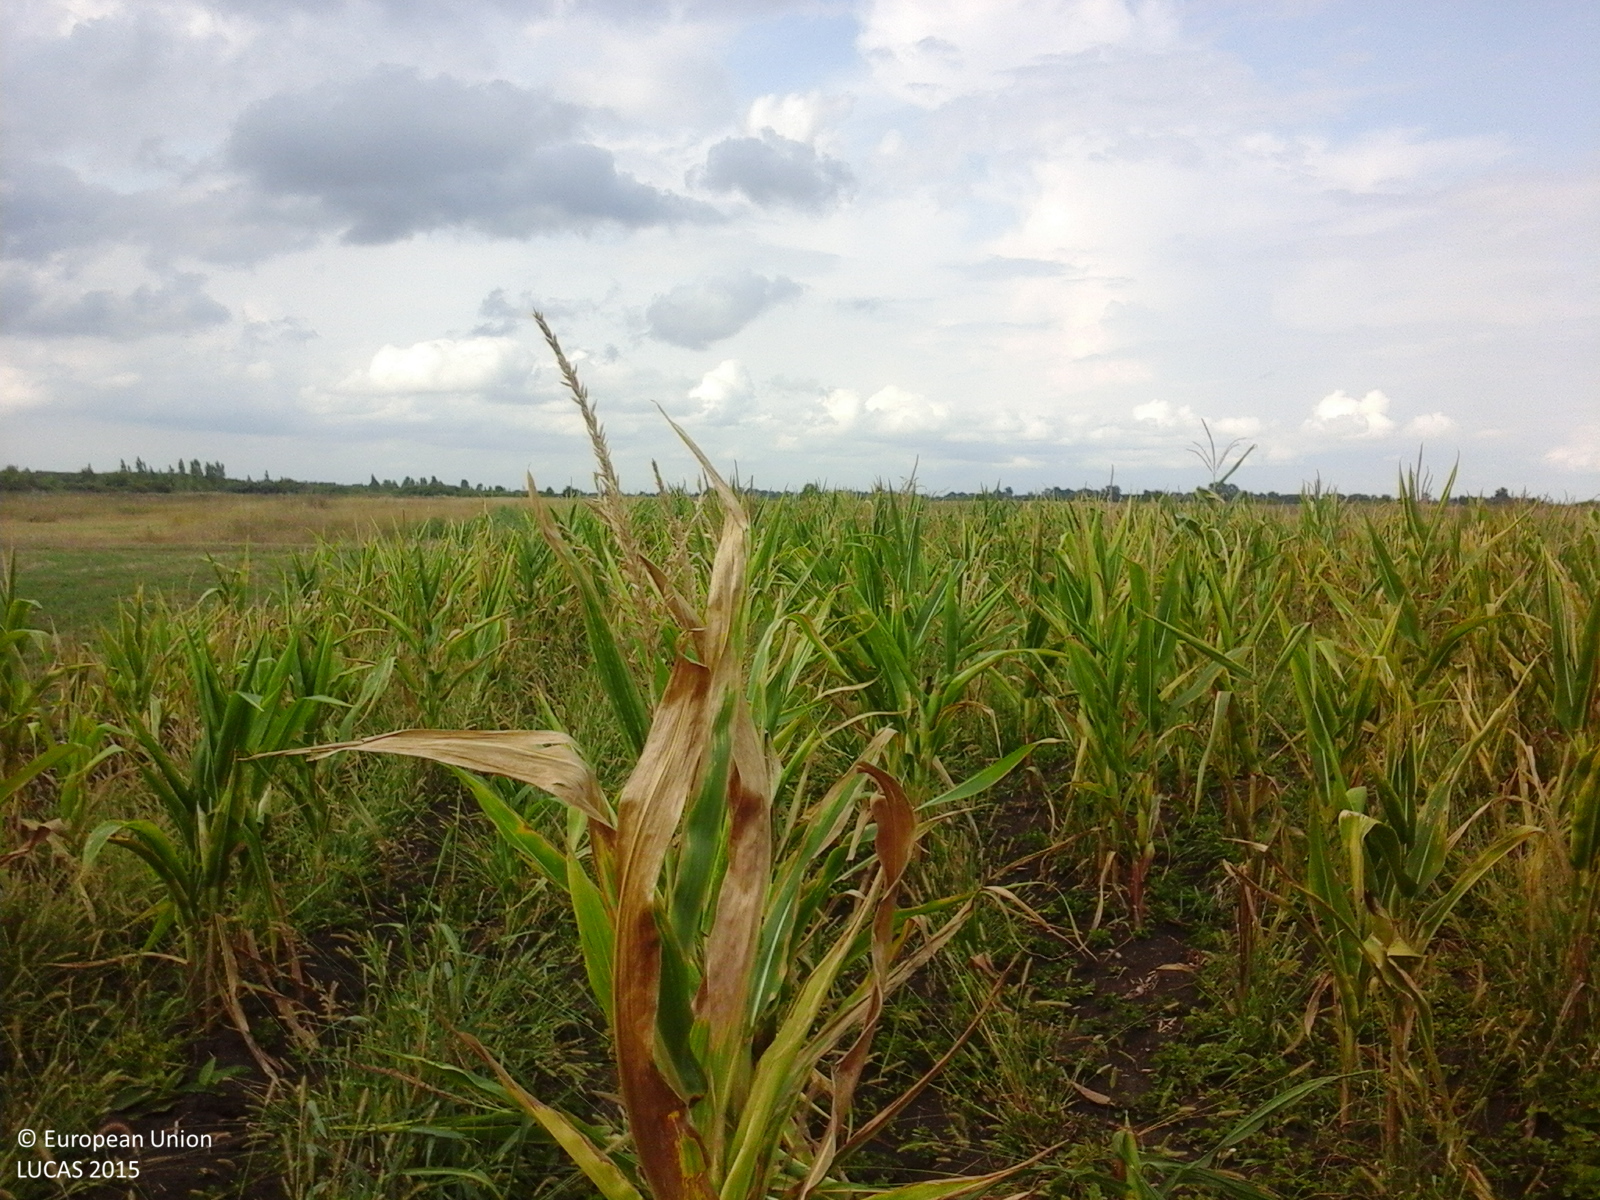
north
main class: Cropland
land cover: Maize
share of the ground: > 75 %
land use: Agriculture (excluding fallow land and kitchen gardens)
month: August
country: RO
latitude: 45.5911
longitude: 21.4275
